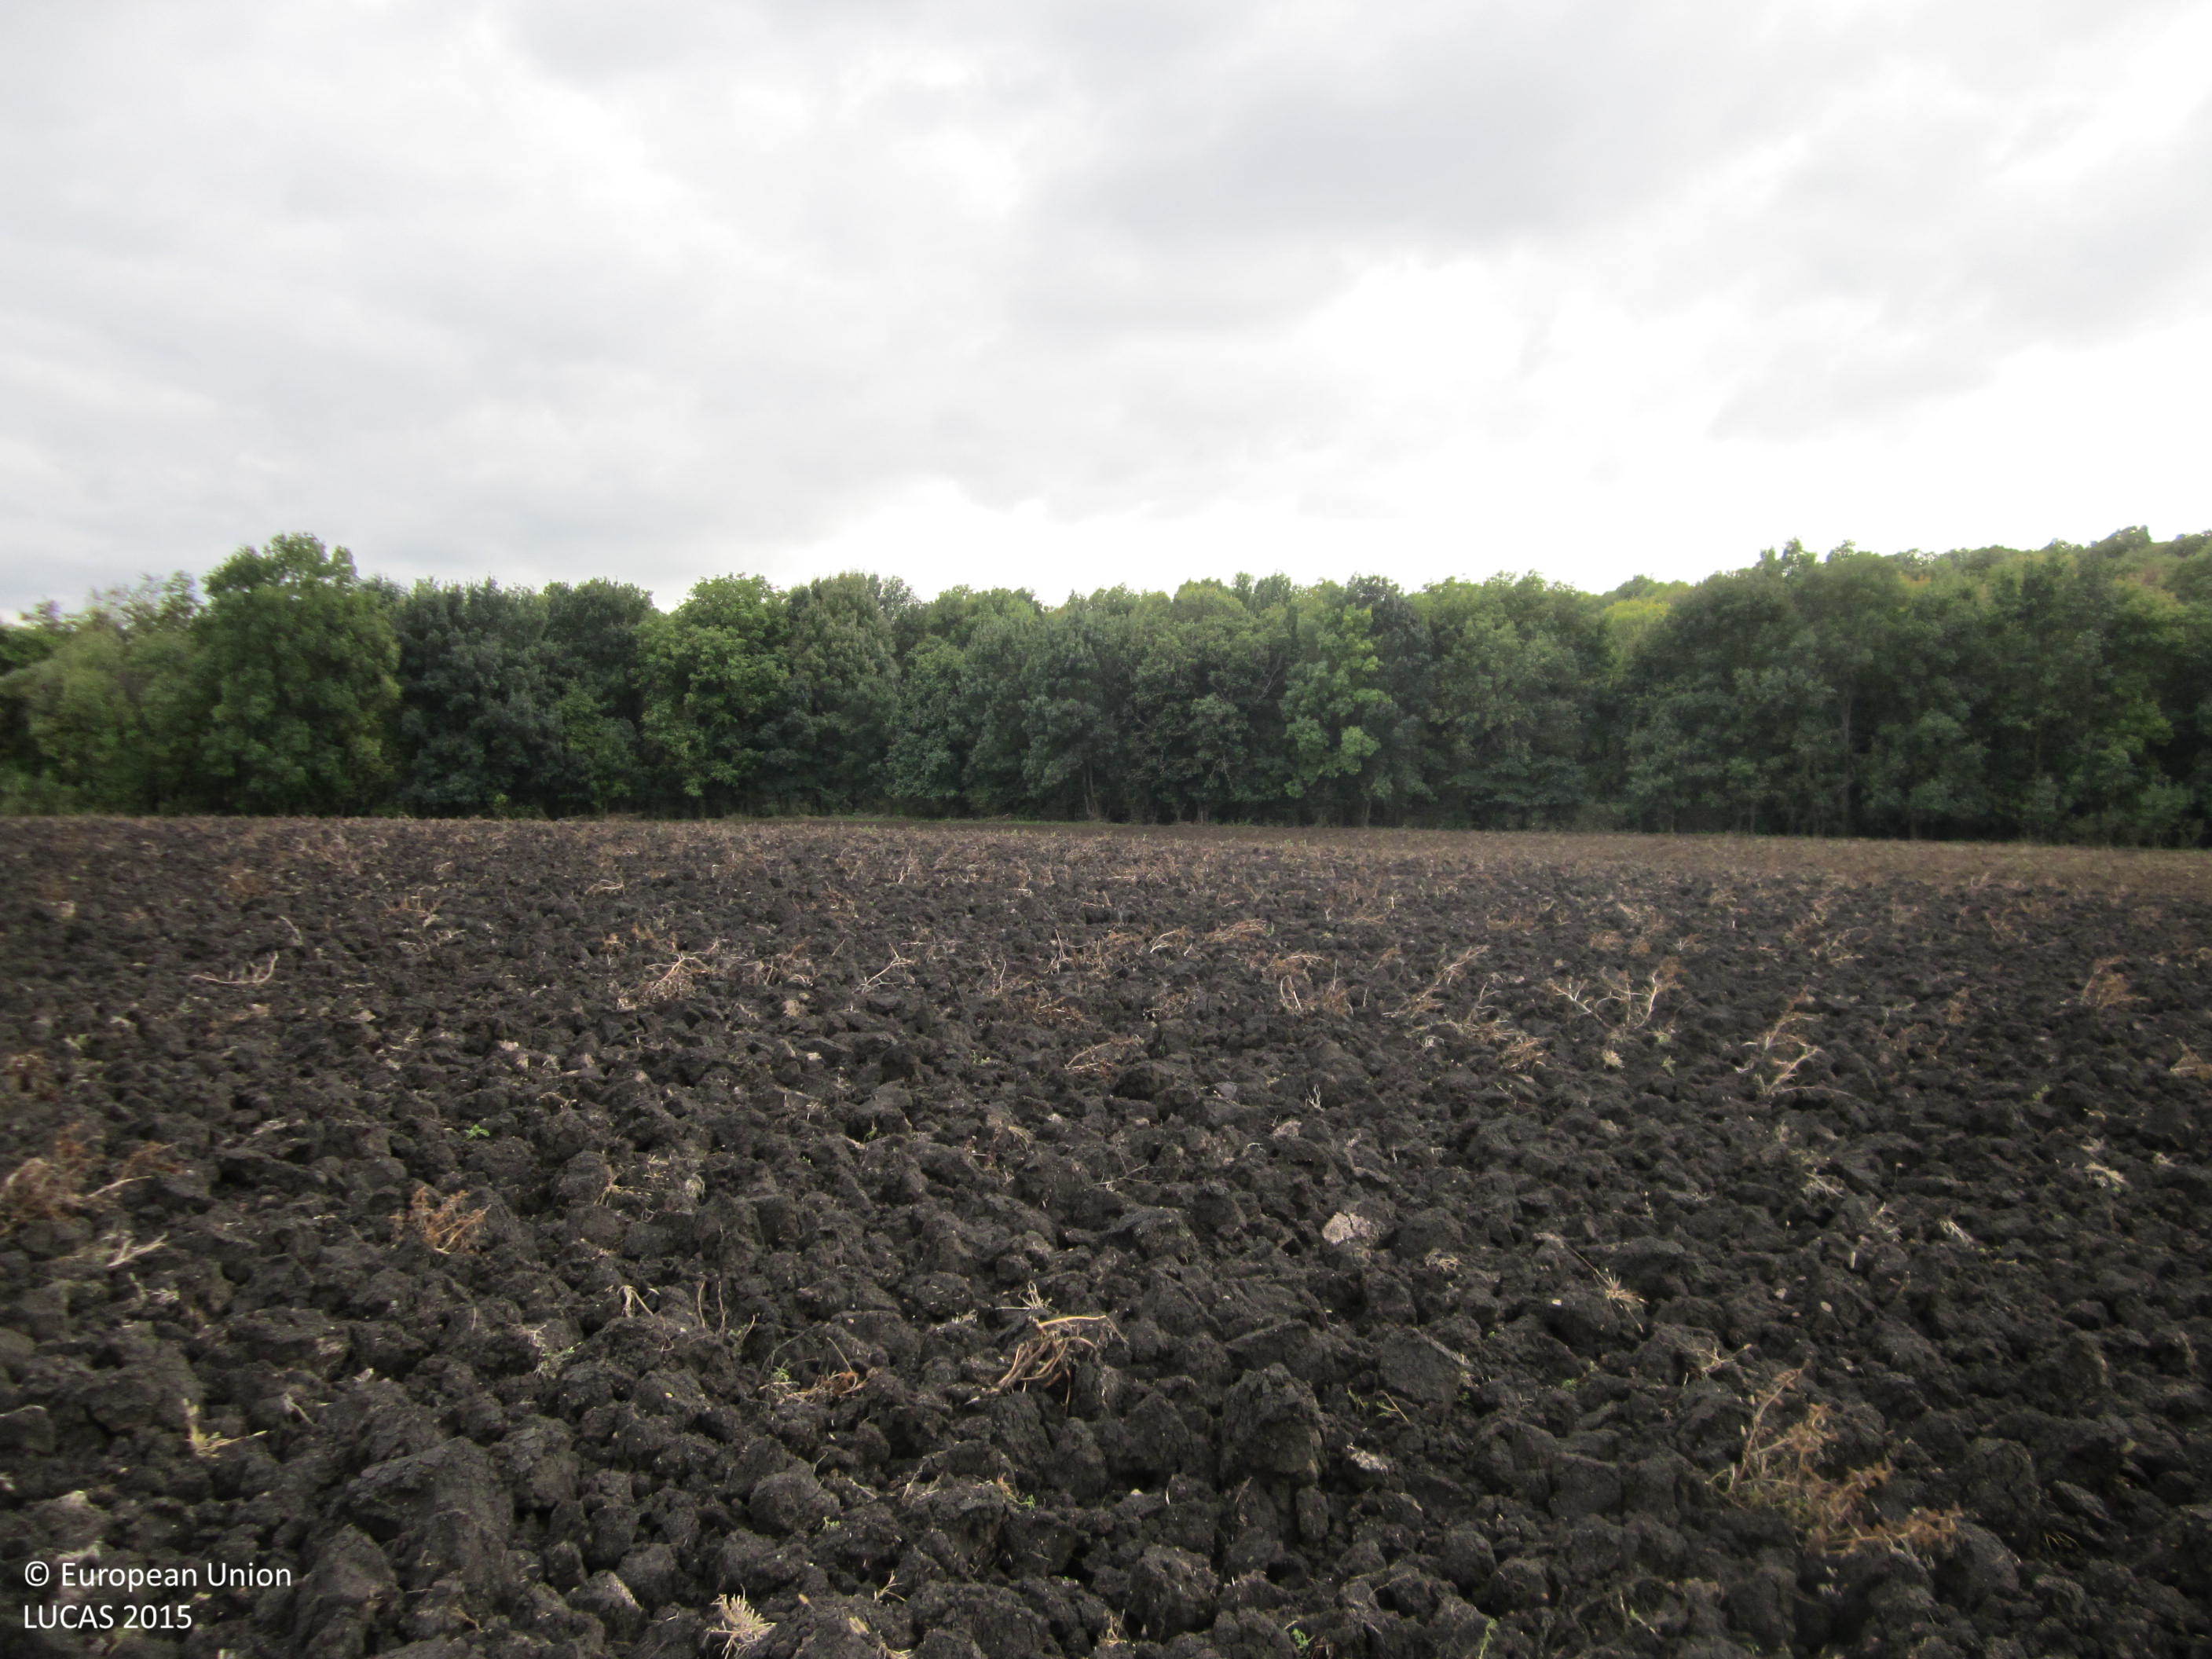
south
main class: Cropland
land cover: Common wheat
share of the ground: < 10 %
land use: Agriculture (excluding fallow land and kitchen gardens)
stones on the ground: < 10 %
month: October
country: BG
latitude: 42.3752
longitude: 27.0456
